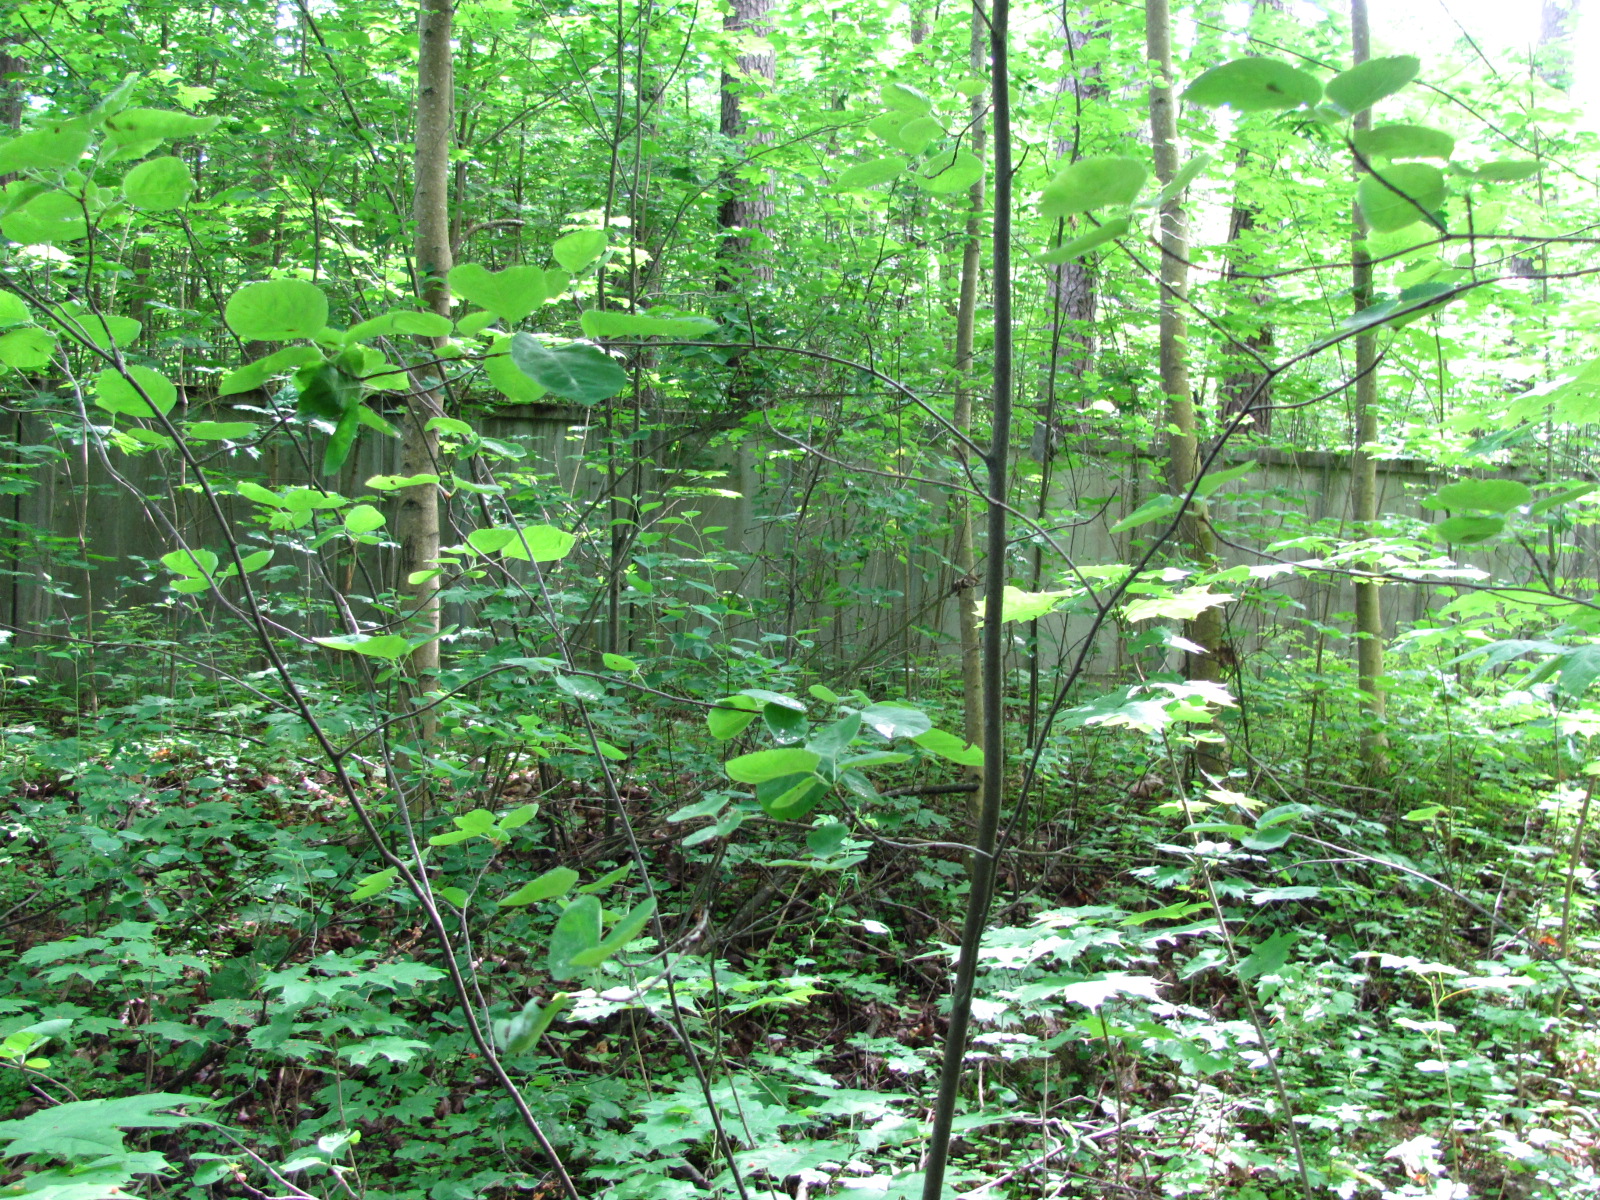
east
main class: Woodland
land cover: Pine dominated mixed woodland
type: hemiboreal forest and nemoral coniferous forest and mixed broadleaved-coniferous forest
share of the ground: > 75 %
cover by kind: broadleaved forest trees 60 %, coniferous forest trees 40 %
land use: Forestry
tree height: > 5 m
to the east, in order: Pine dominated mixed woodland; Fences; Pine dominated mixed woodland; Fences; Grass margins; Electric lines; Paved roads, cycling and walking lanes; Pine dominated mixed woodland; Paved roads, cycling and walking lanes; Fences; Grassland without tree/shrub cover; Broadleaved woodland; Inland fresh running water; Broadleaved woodland
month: June
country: LV
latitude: 56.9853
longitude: 24.0217
